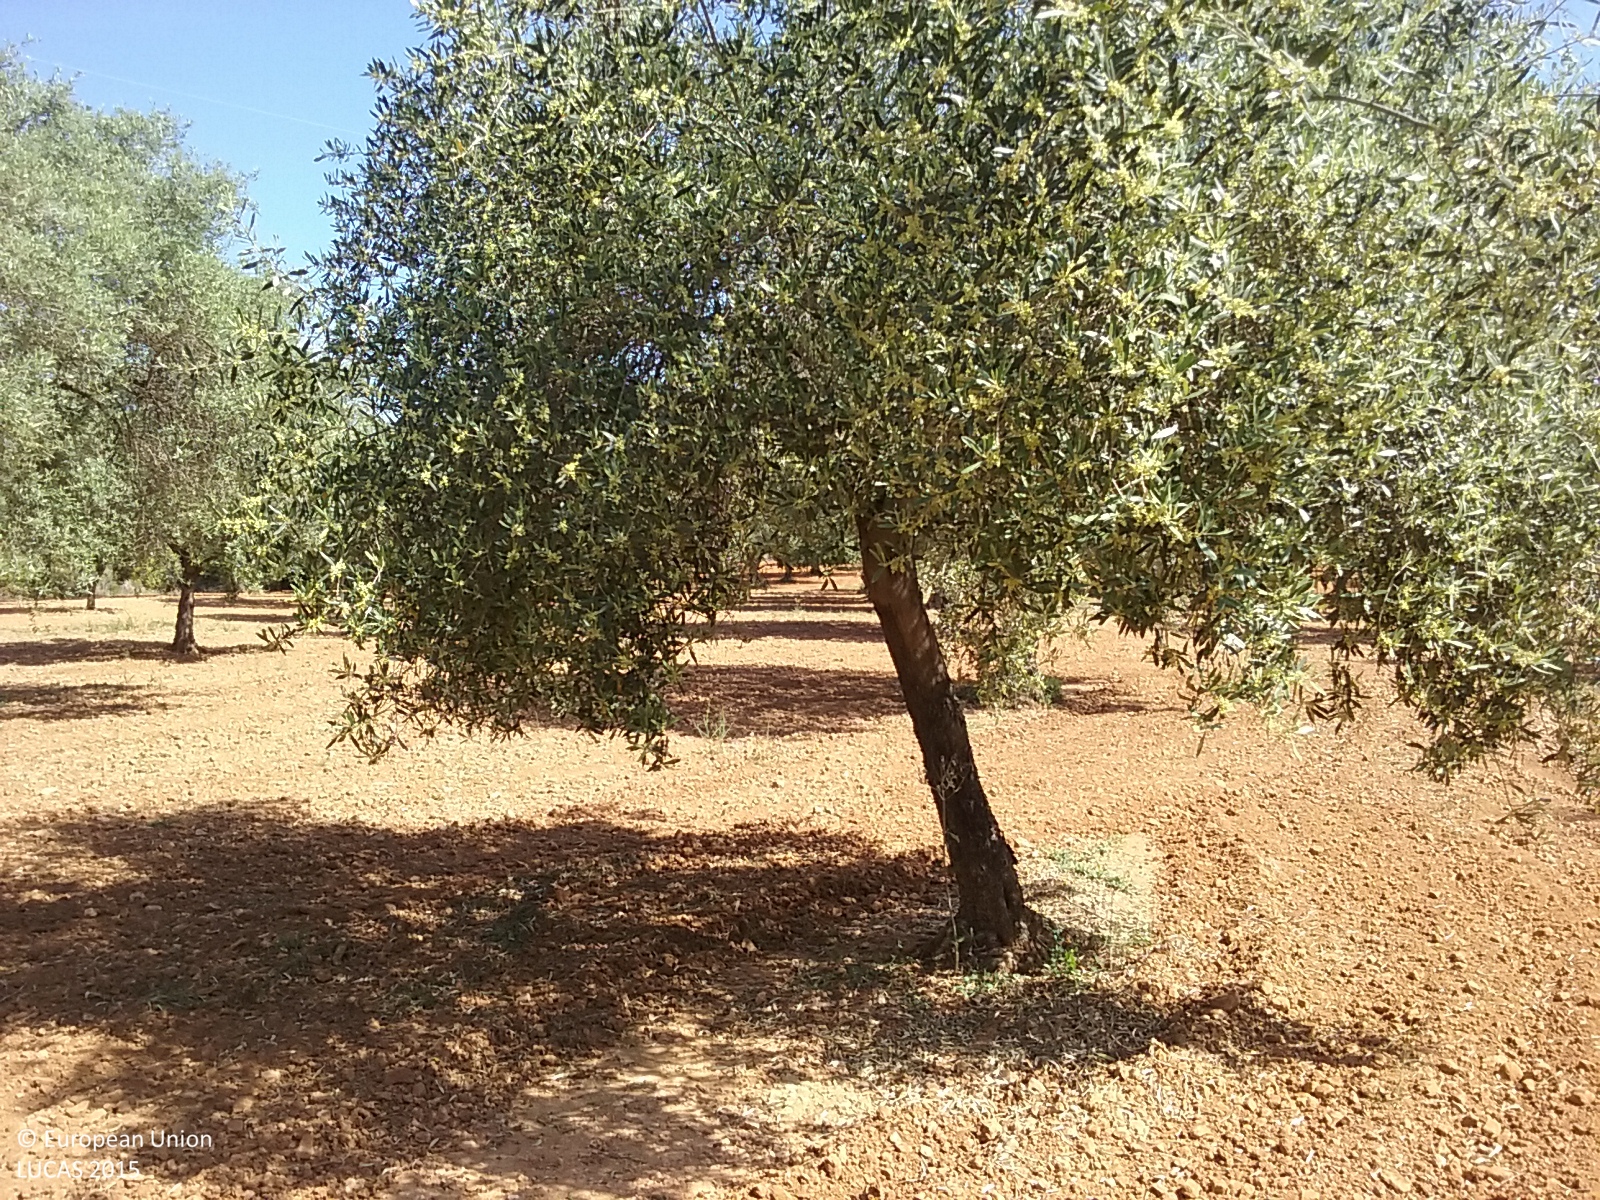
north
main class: Cropland
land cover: Olive groves
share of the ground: 50 - 75 %
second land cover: Other bare soil
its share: > 75 %
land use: Agriculture (excluding fallow land and kitchen gardens)
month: May
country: ES
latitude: 40.5504
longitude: 0.3003
